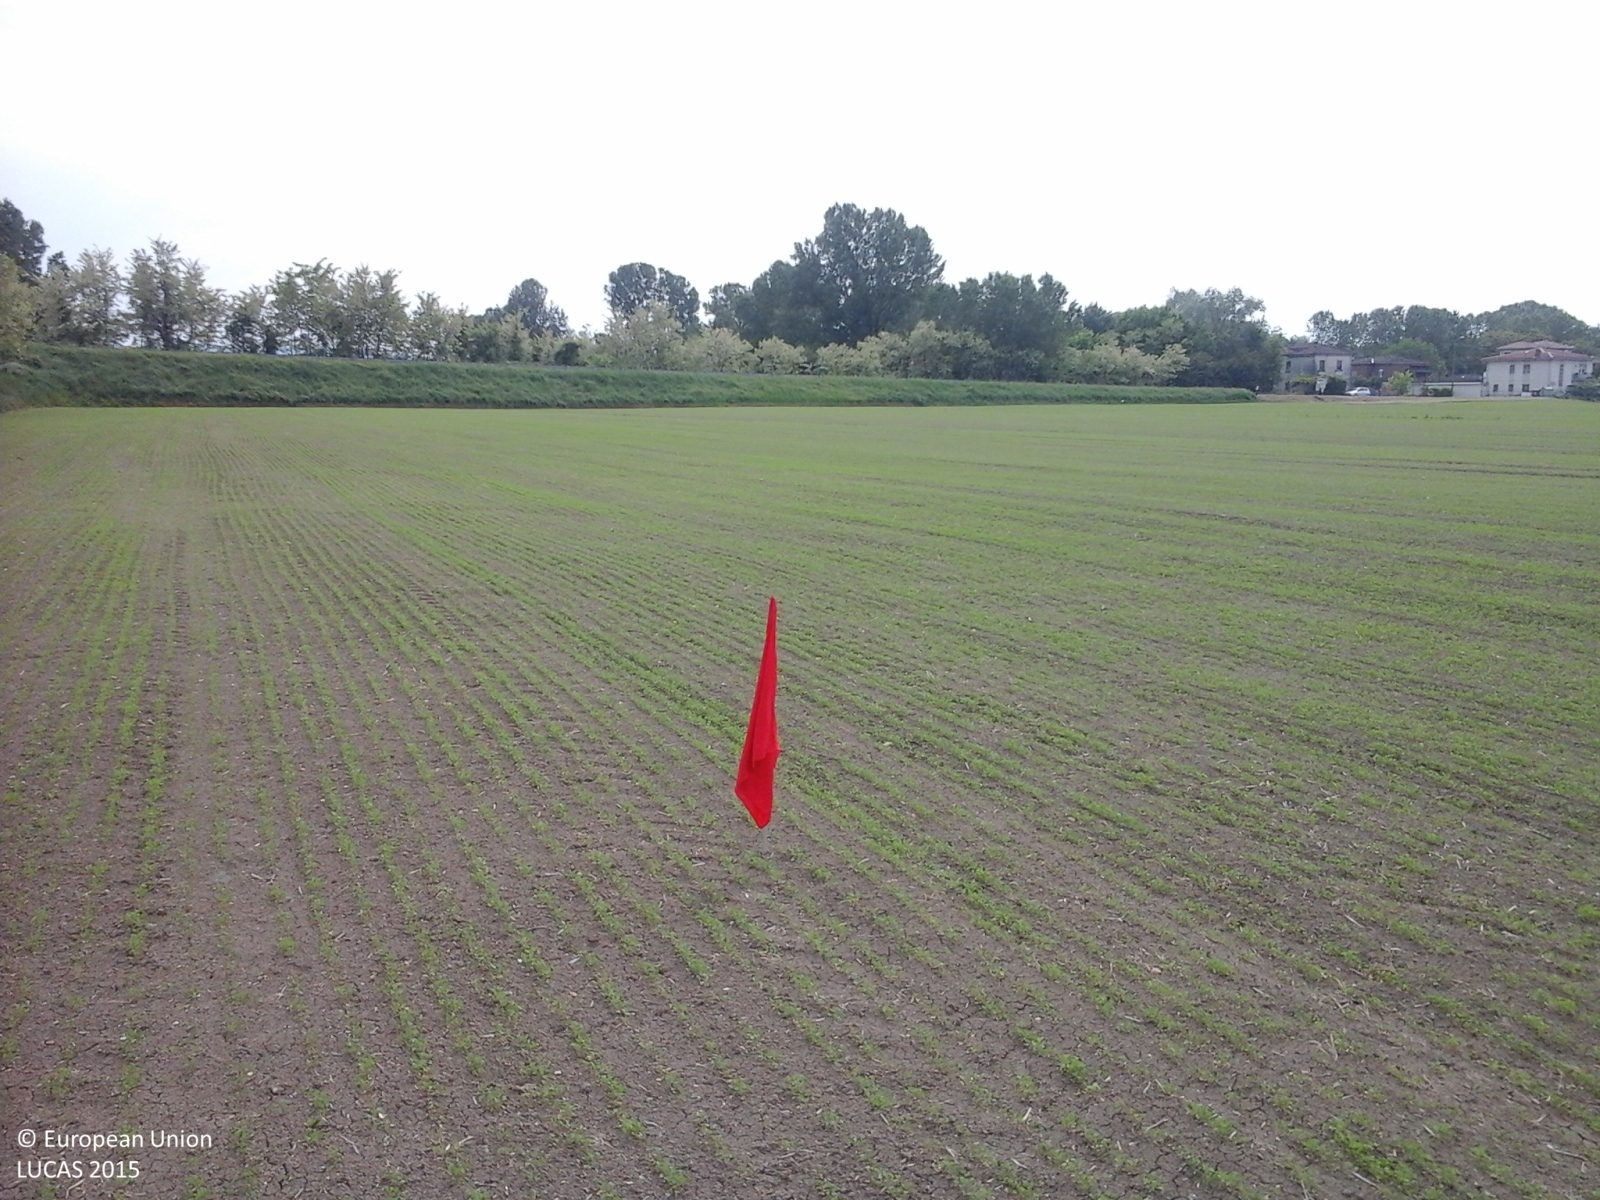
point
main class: Cropland
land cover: Lucerne
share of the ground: < 10 %
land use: Agriculture (excluding fallow land and kitchen gardens)
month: May
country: IT
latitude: 45.0686
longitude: 9.1760
